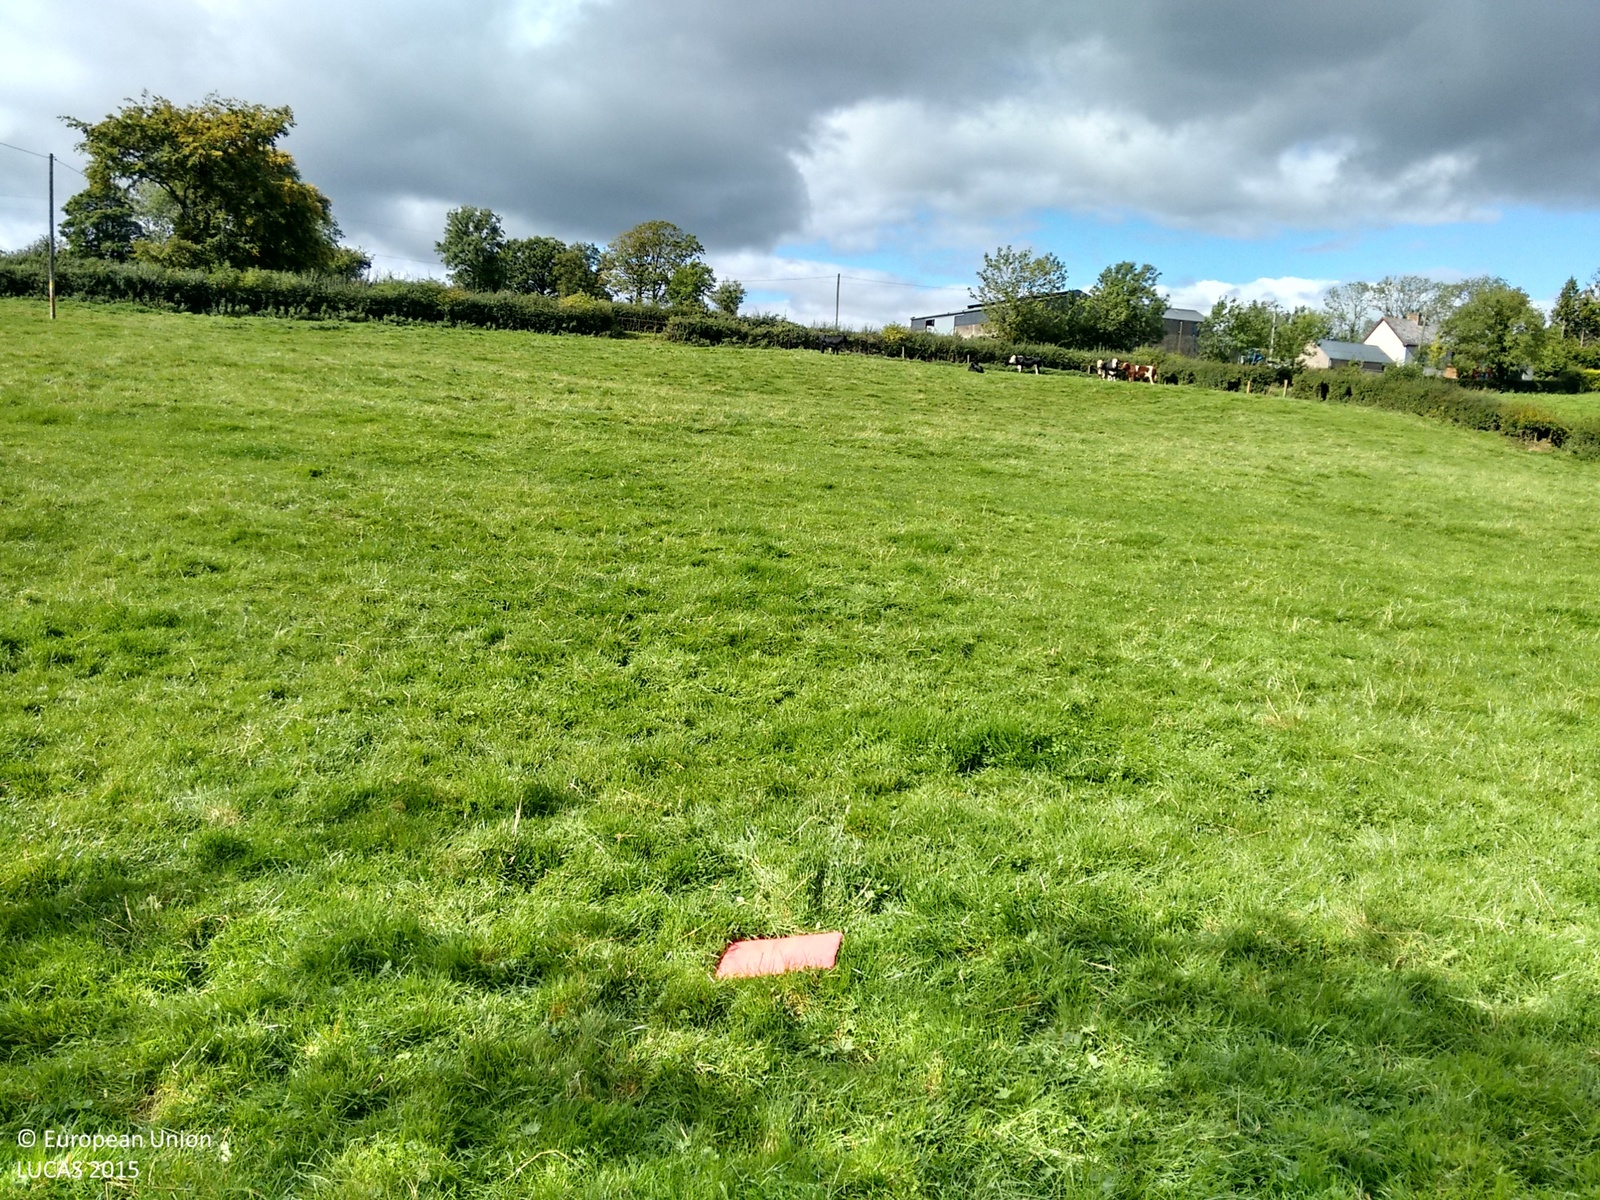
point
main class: Grassland
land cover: Grassland without tree/shrub cover
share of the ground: > 75 %
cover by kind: herbaceous plants 95 %, shrubs 5 %
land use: Agriculture (excluding fallow land and kitchen gardens)
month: September
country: IE
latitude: 54.2774
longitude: -6.9241
